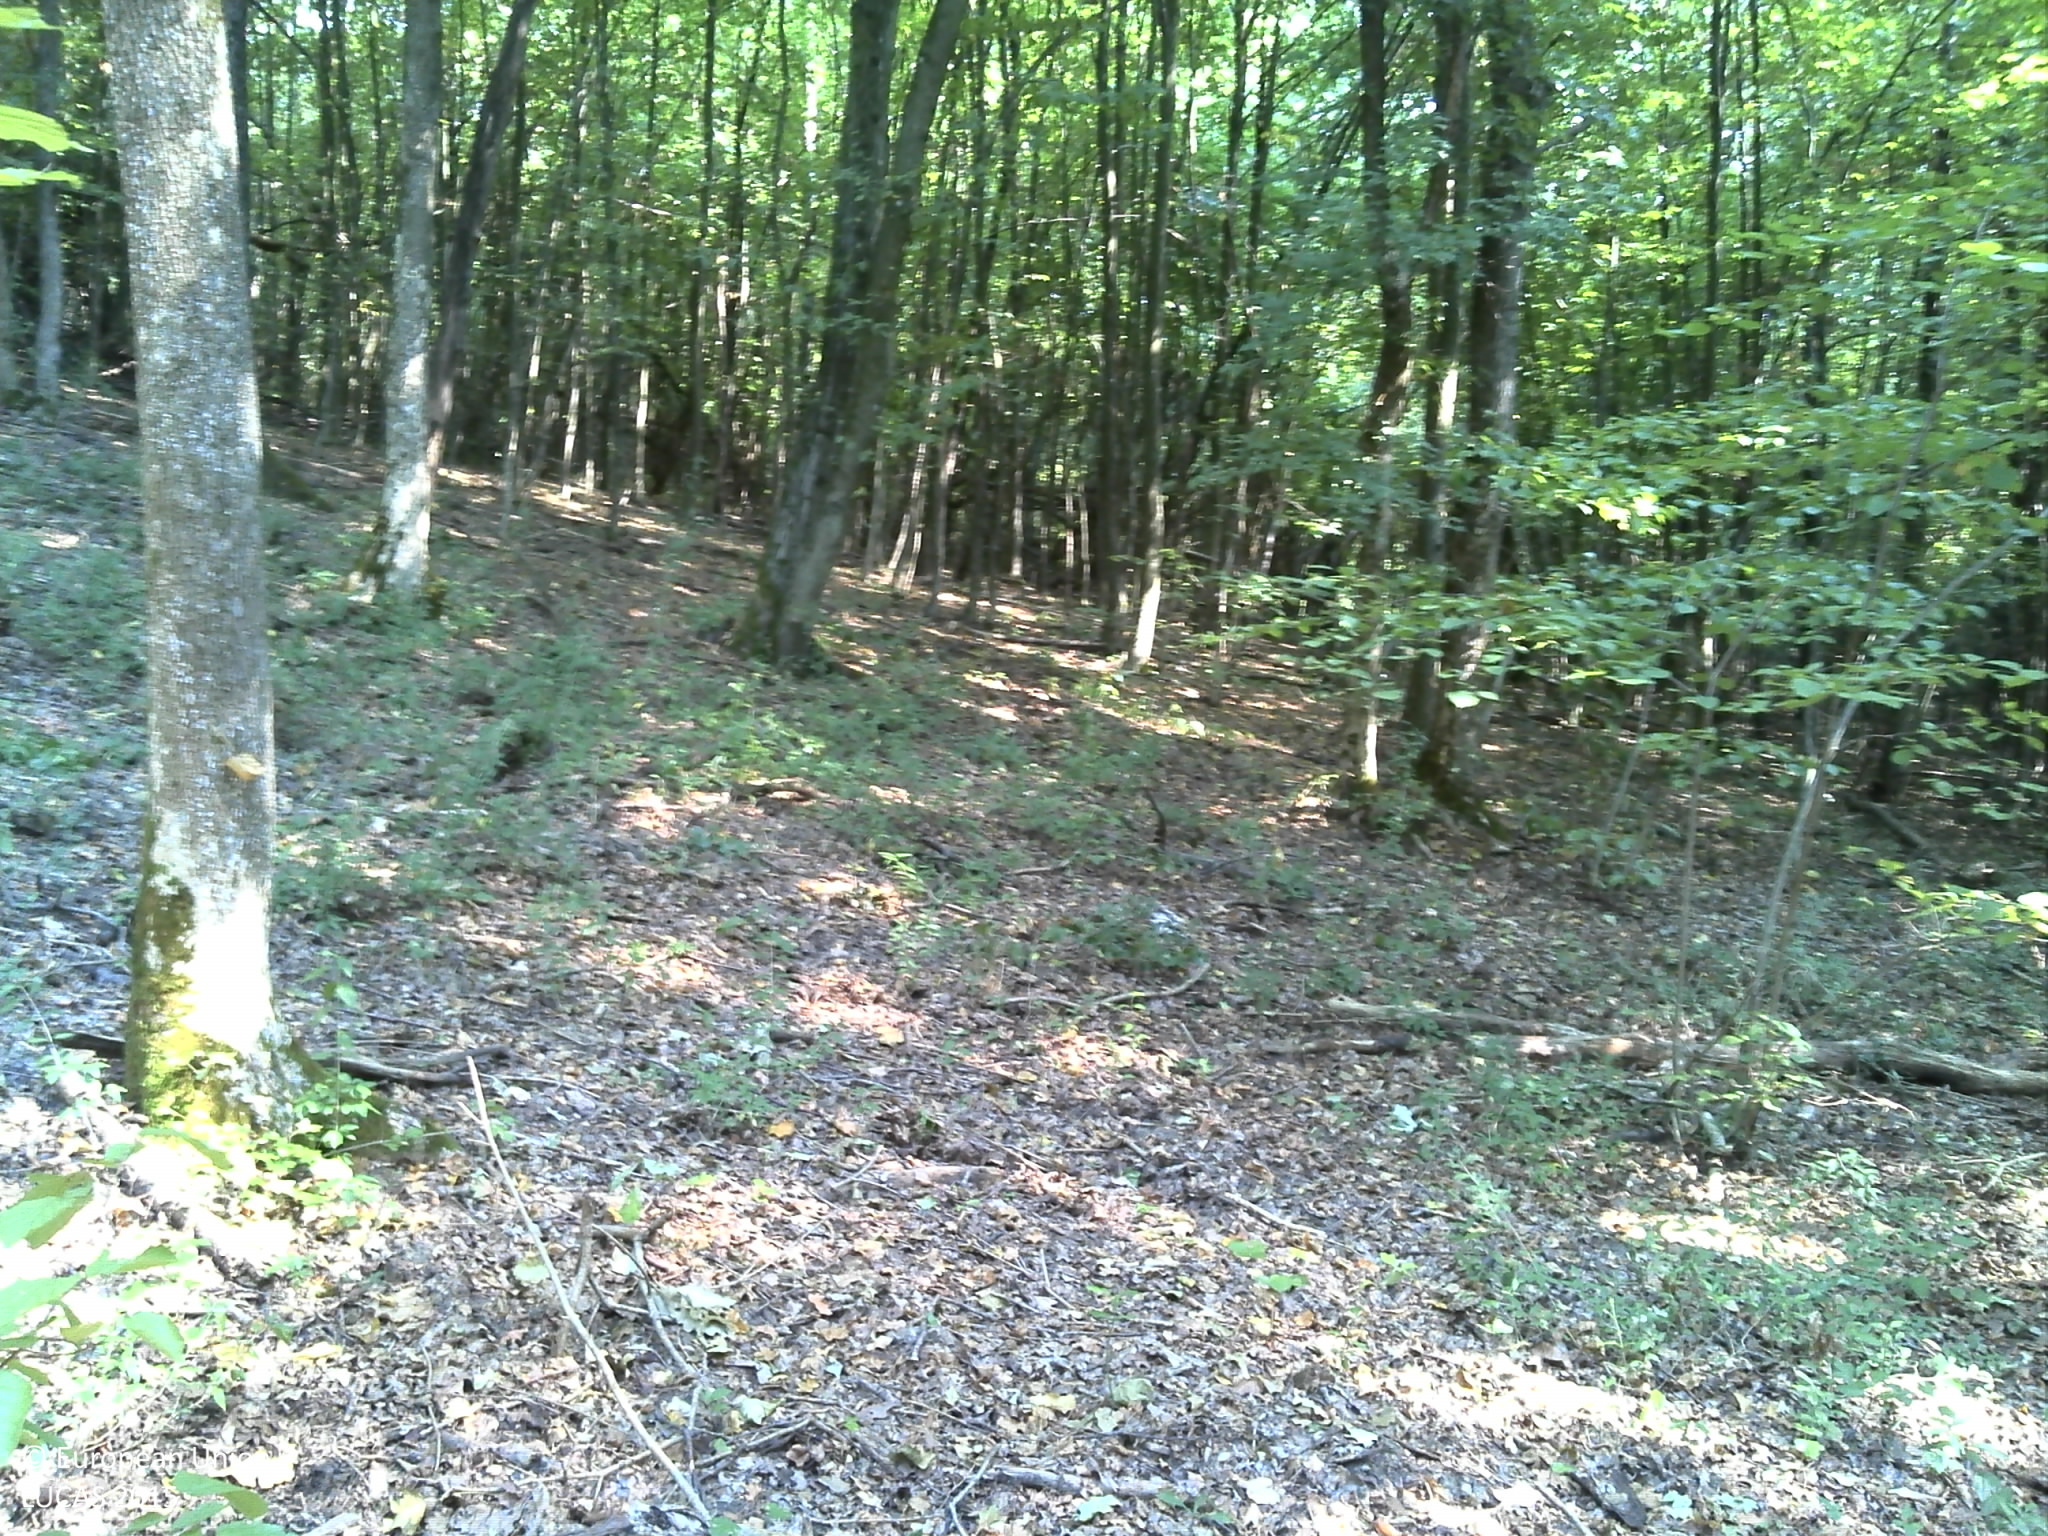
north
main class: Woodland
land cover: Broadleaved woodland
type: acidophilous oak and oak-birch forest
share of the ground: > 75 %
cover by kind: broadleaved forest trees 100 %
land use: Forestry
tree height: > 5 m
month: August
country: HR
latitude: 45.7103
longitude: 17.4654
